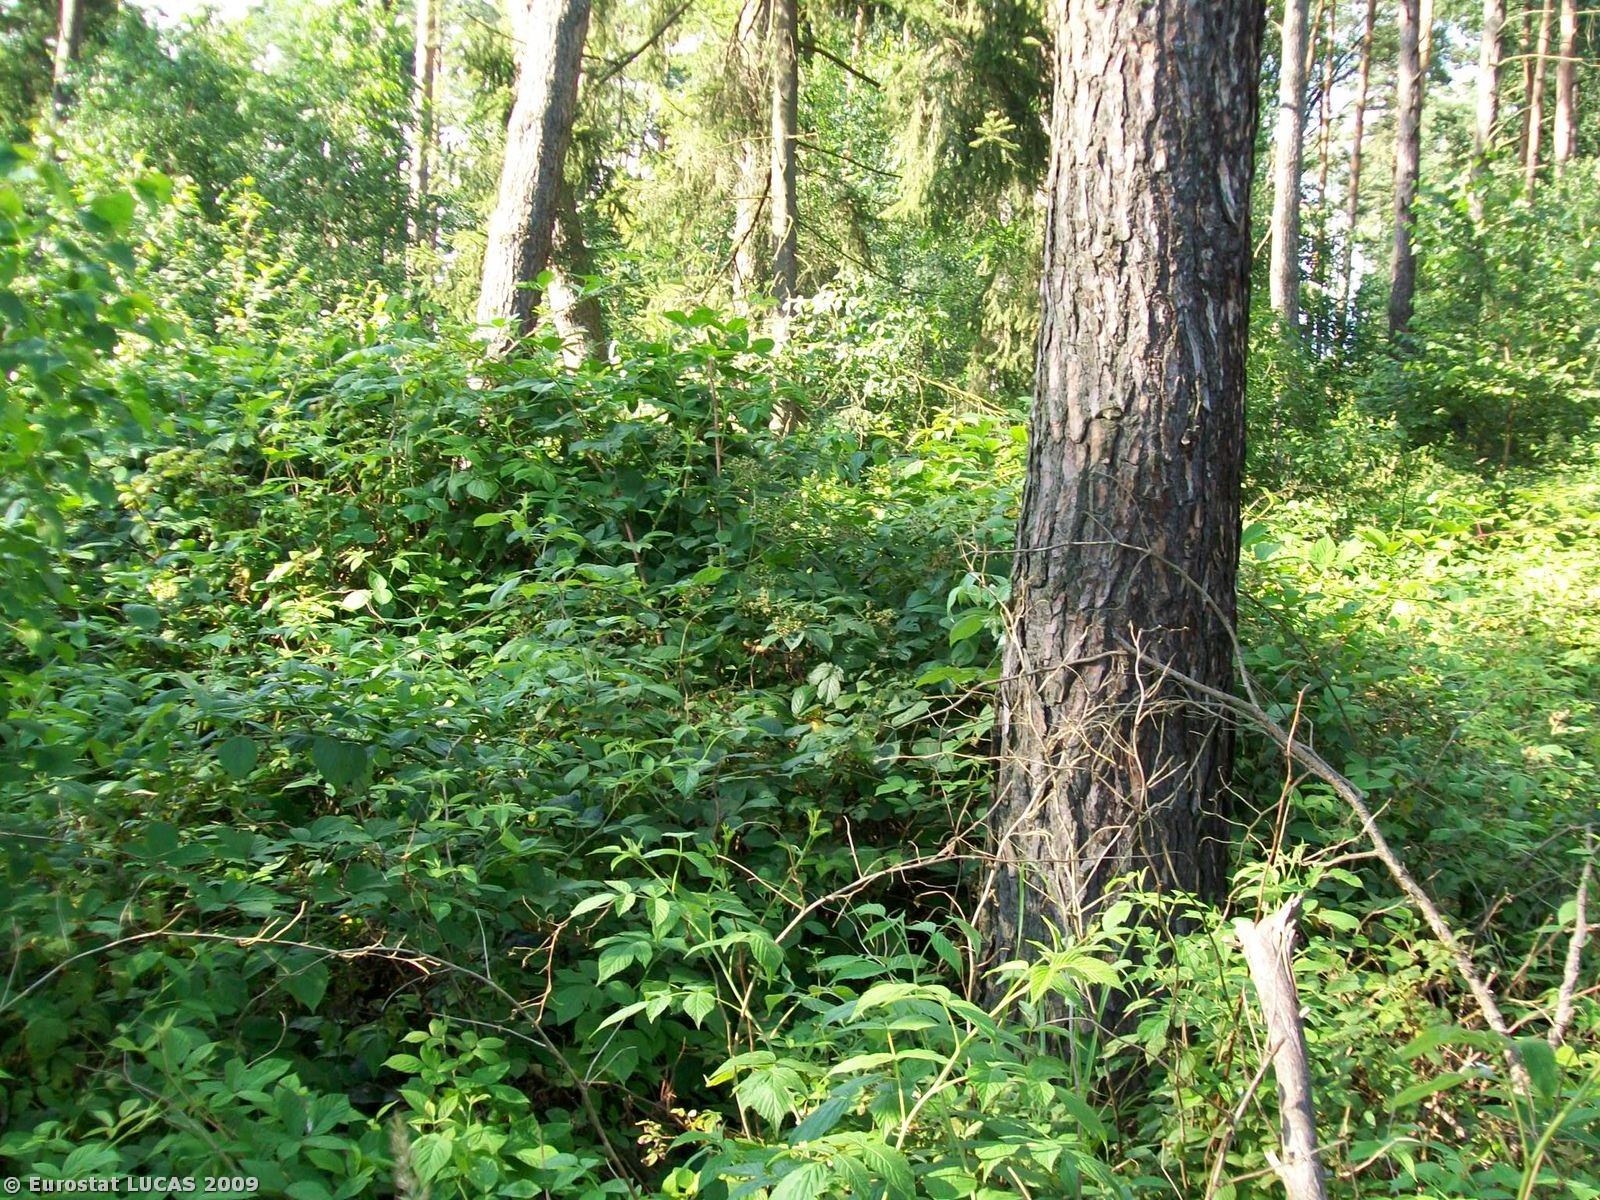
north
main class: Woodland
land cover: Mixed woodland
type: hemiboreal forest and nemoral coniferous forest and mixed broadleaved-coniferous forest
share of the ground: > 75 %
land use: Unused
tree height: > 5 m
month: July
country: PL
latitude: 51.0651
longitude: 17.6480
